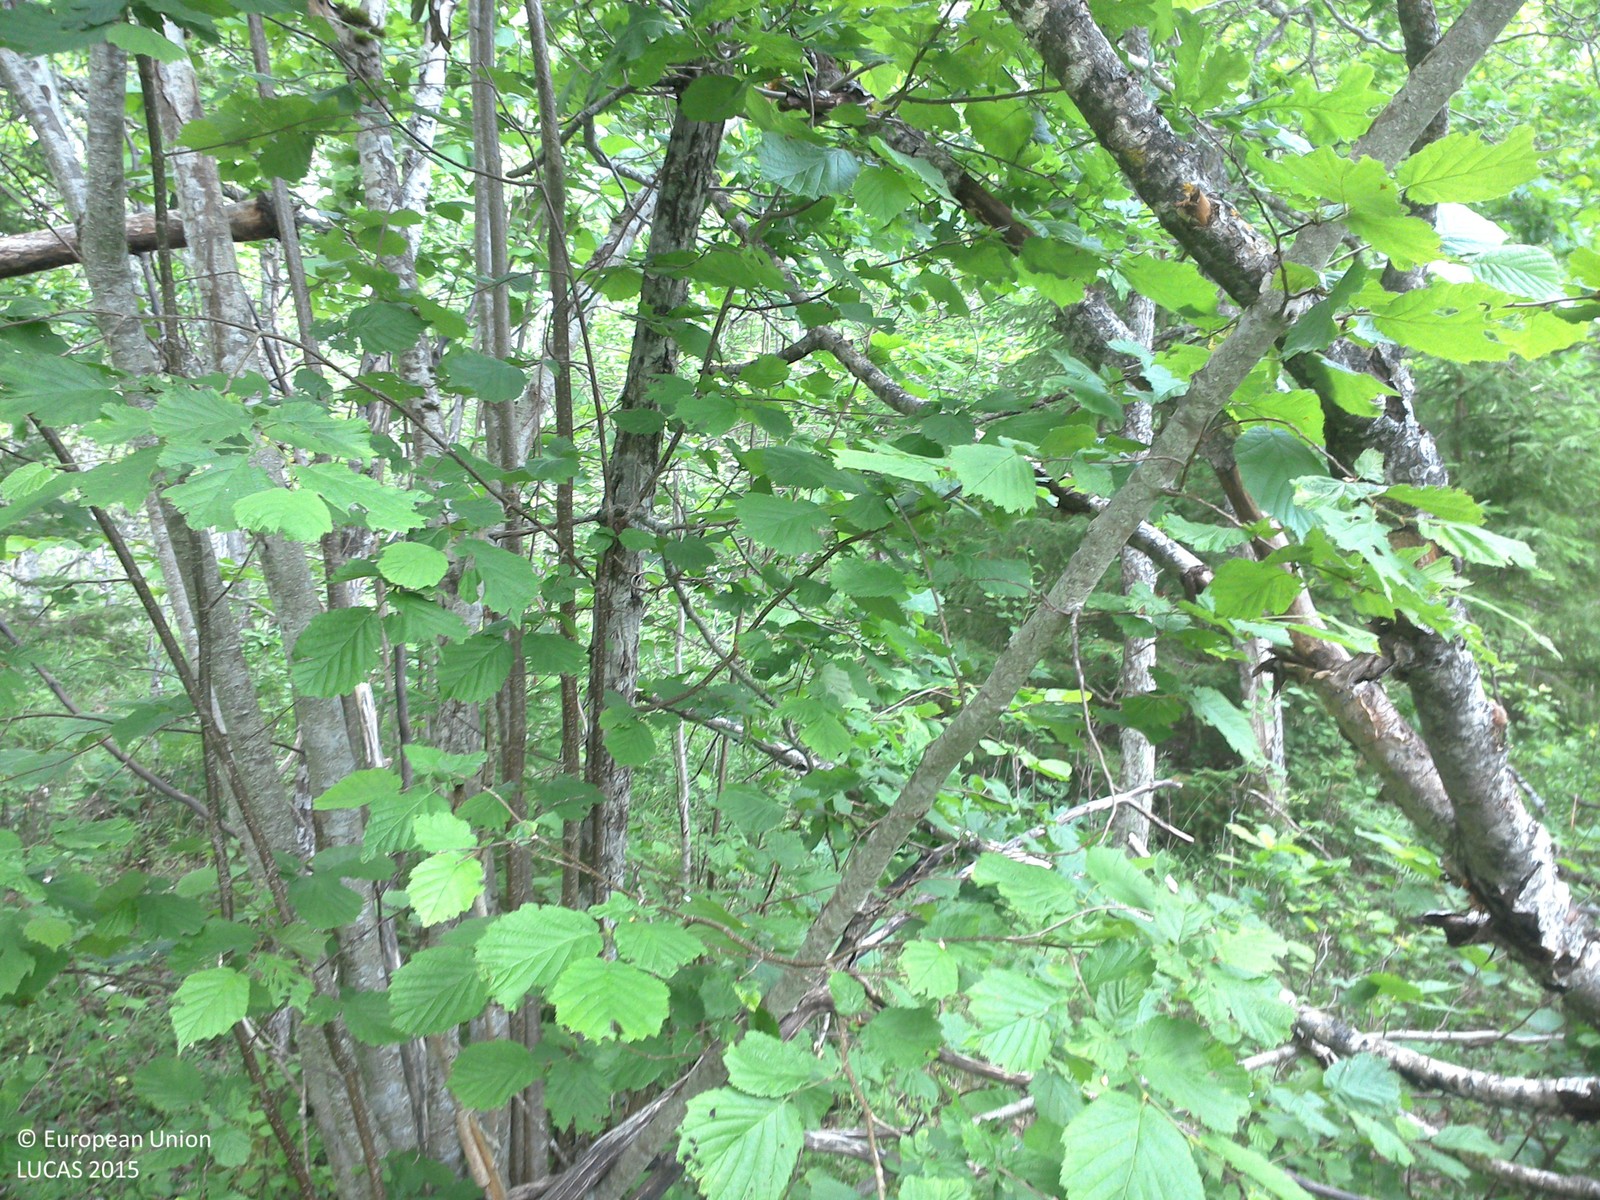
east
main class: Woodland
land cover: Spruce dominated mixed woodland
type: boreal forest
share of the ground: > 75 %
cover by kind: coniferous forest trees 60 %, broadleaved forest trees 30 %, herbaceous plants 10 %
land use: Forestry
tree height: > 5 m
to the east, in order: Spruce dominated mixed woodland; Broadleaved woodland; Fences; Grassland with sparse tree/shrub cover; Ditches and canals; Grassland without tree/shrub cover
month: June
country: SE
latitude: 58.2113
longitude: 15.5946
